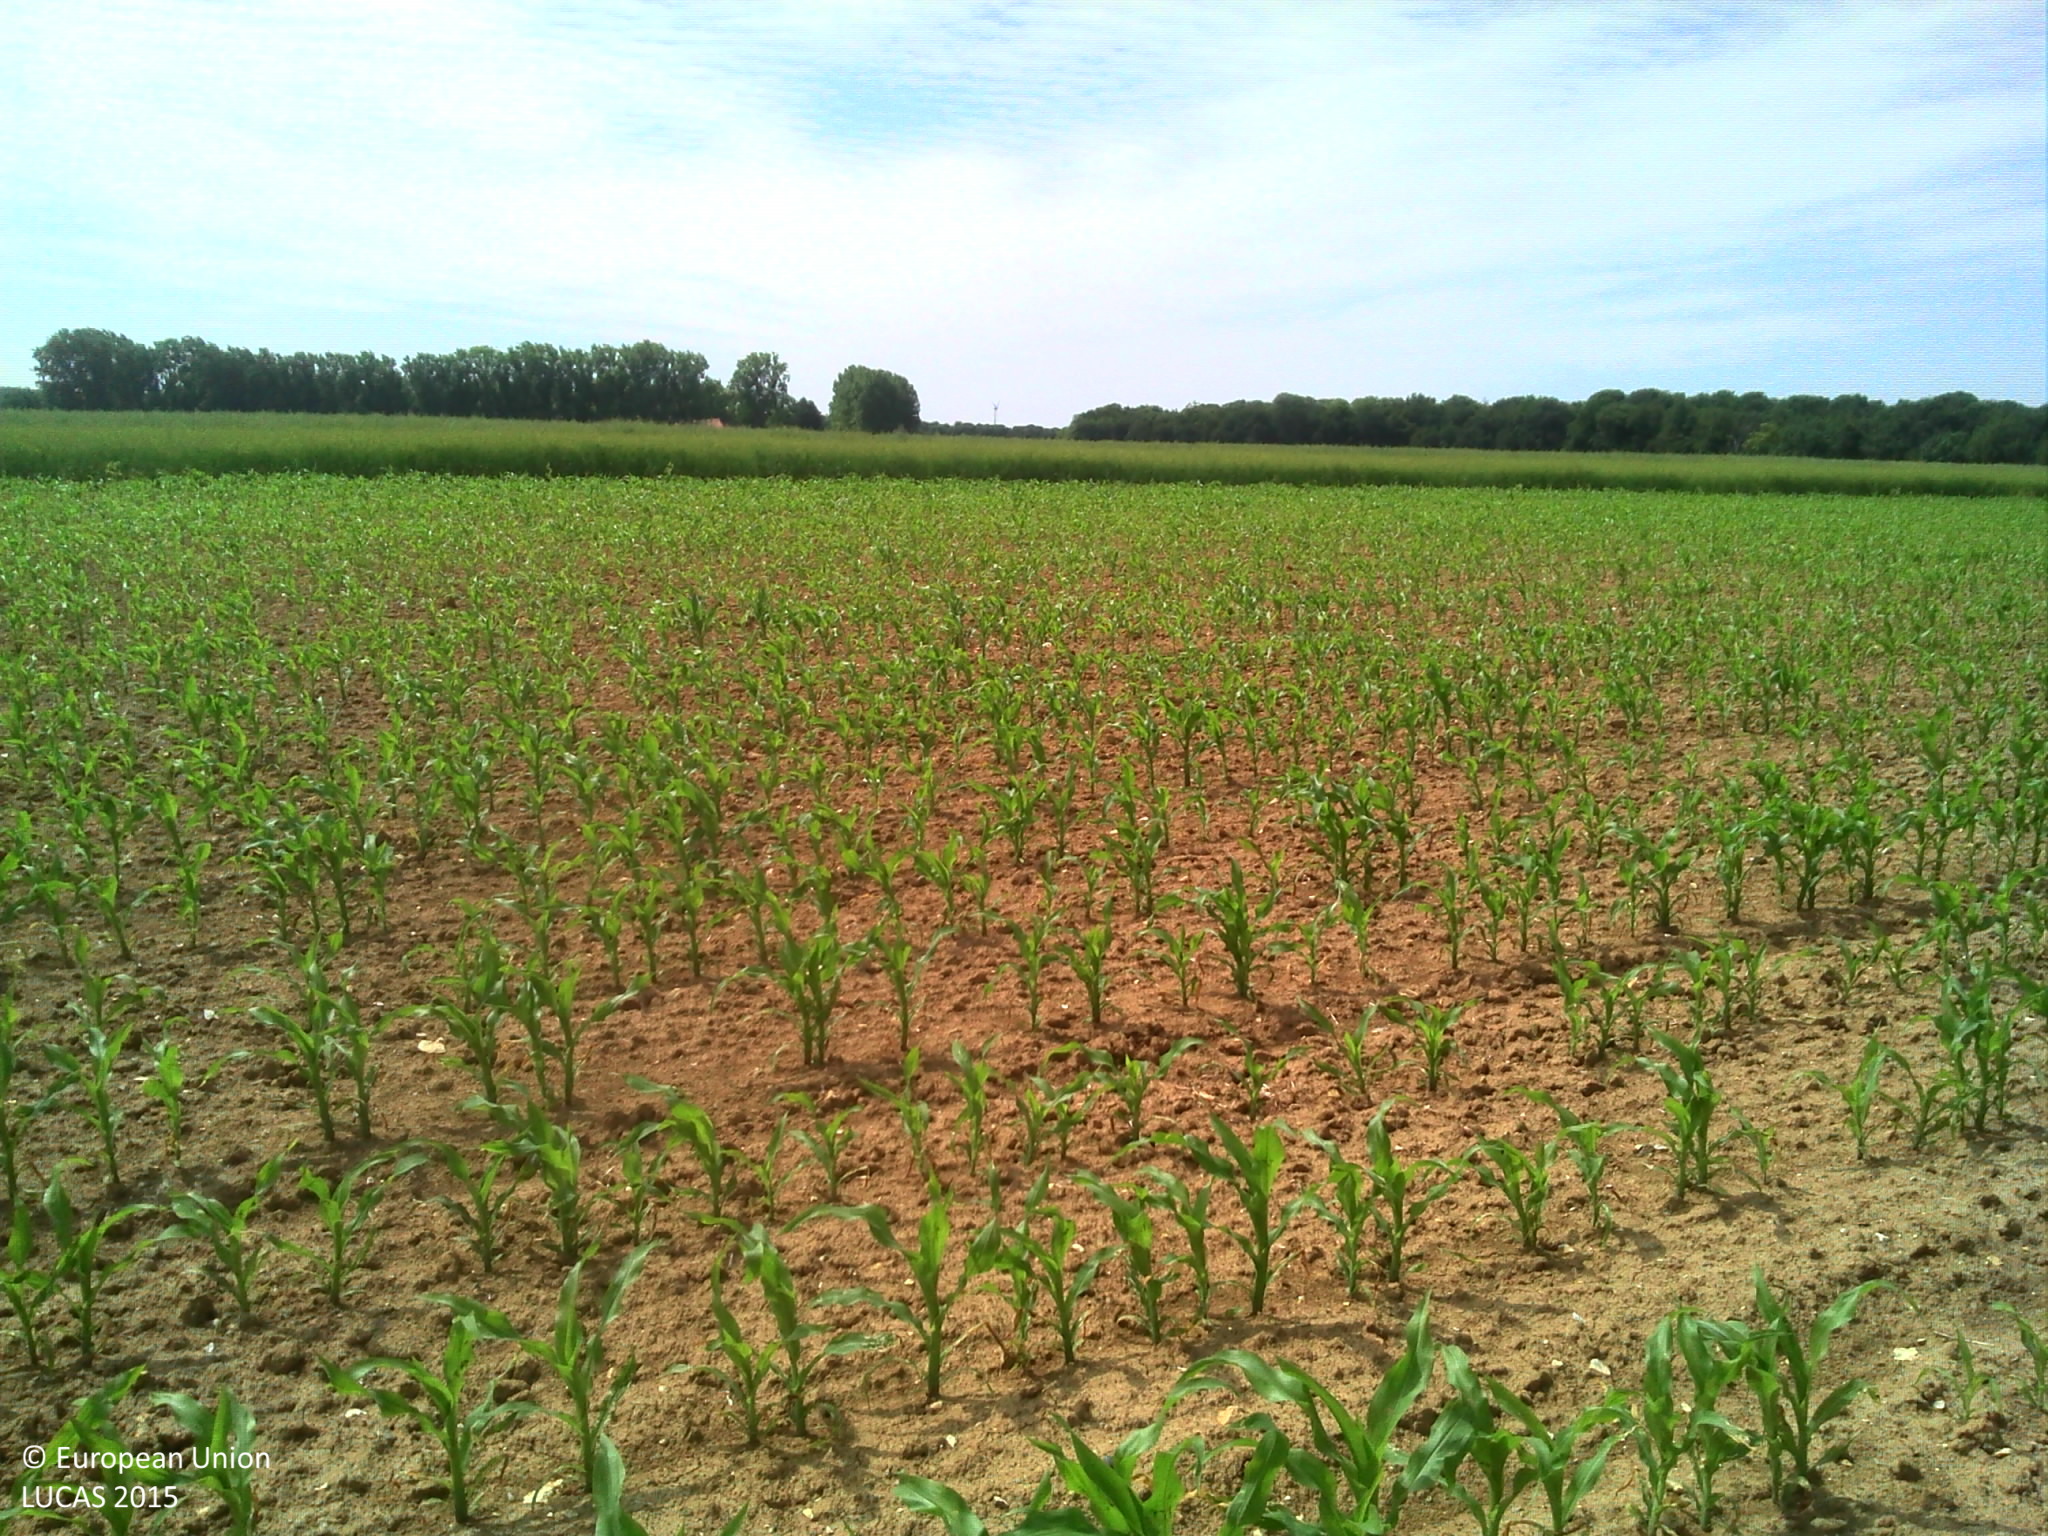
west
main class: Cropland
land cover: Maize
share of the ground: 25 - 50 %
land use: Agriculture (excluding fallow land and kitchen gardens)
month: June
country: FR
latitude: 49.7617
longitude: 2.3097
